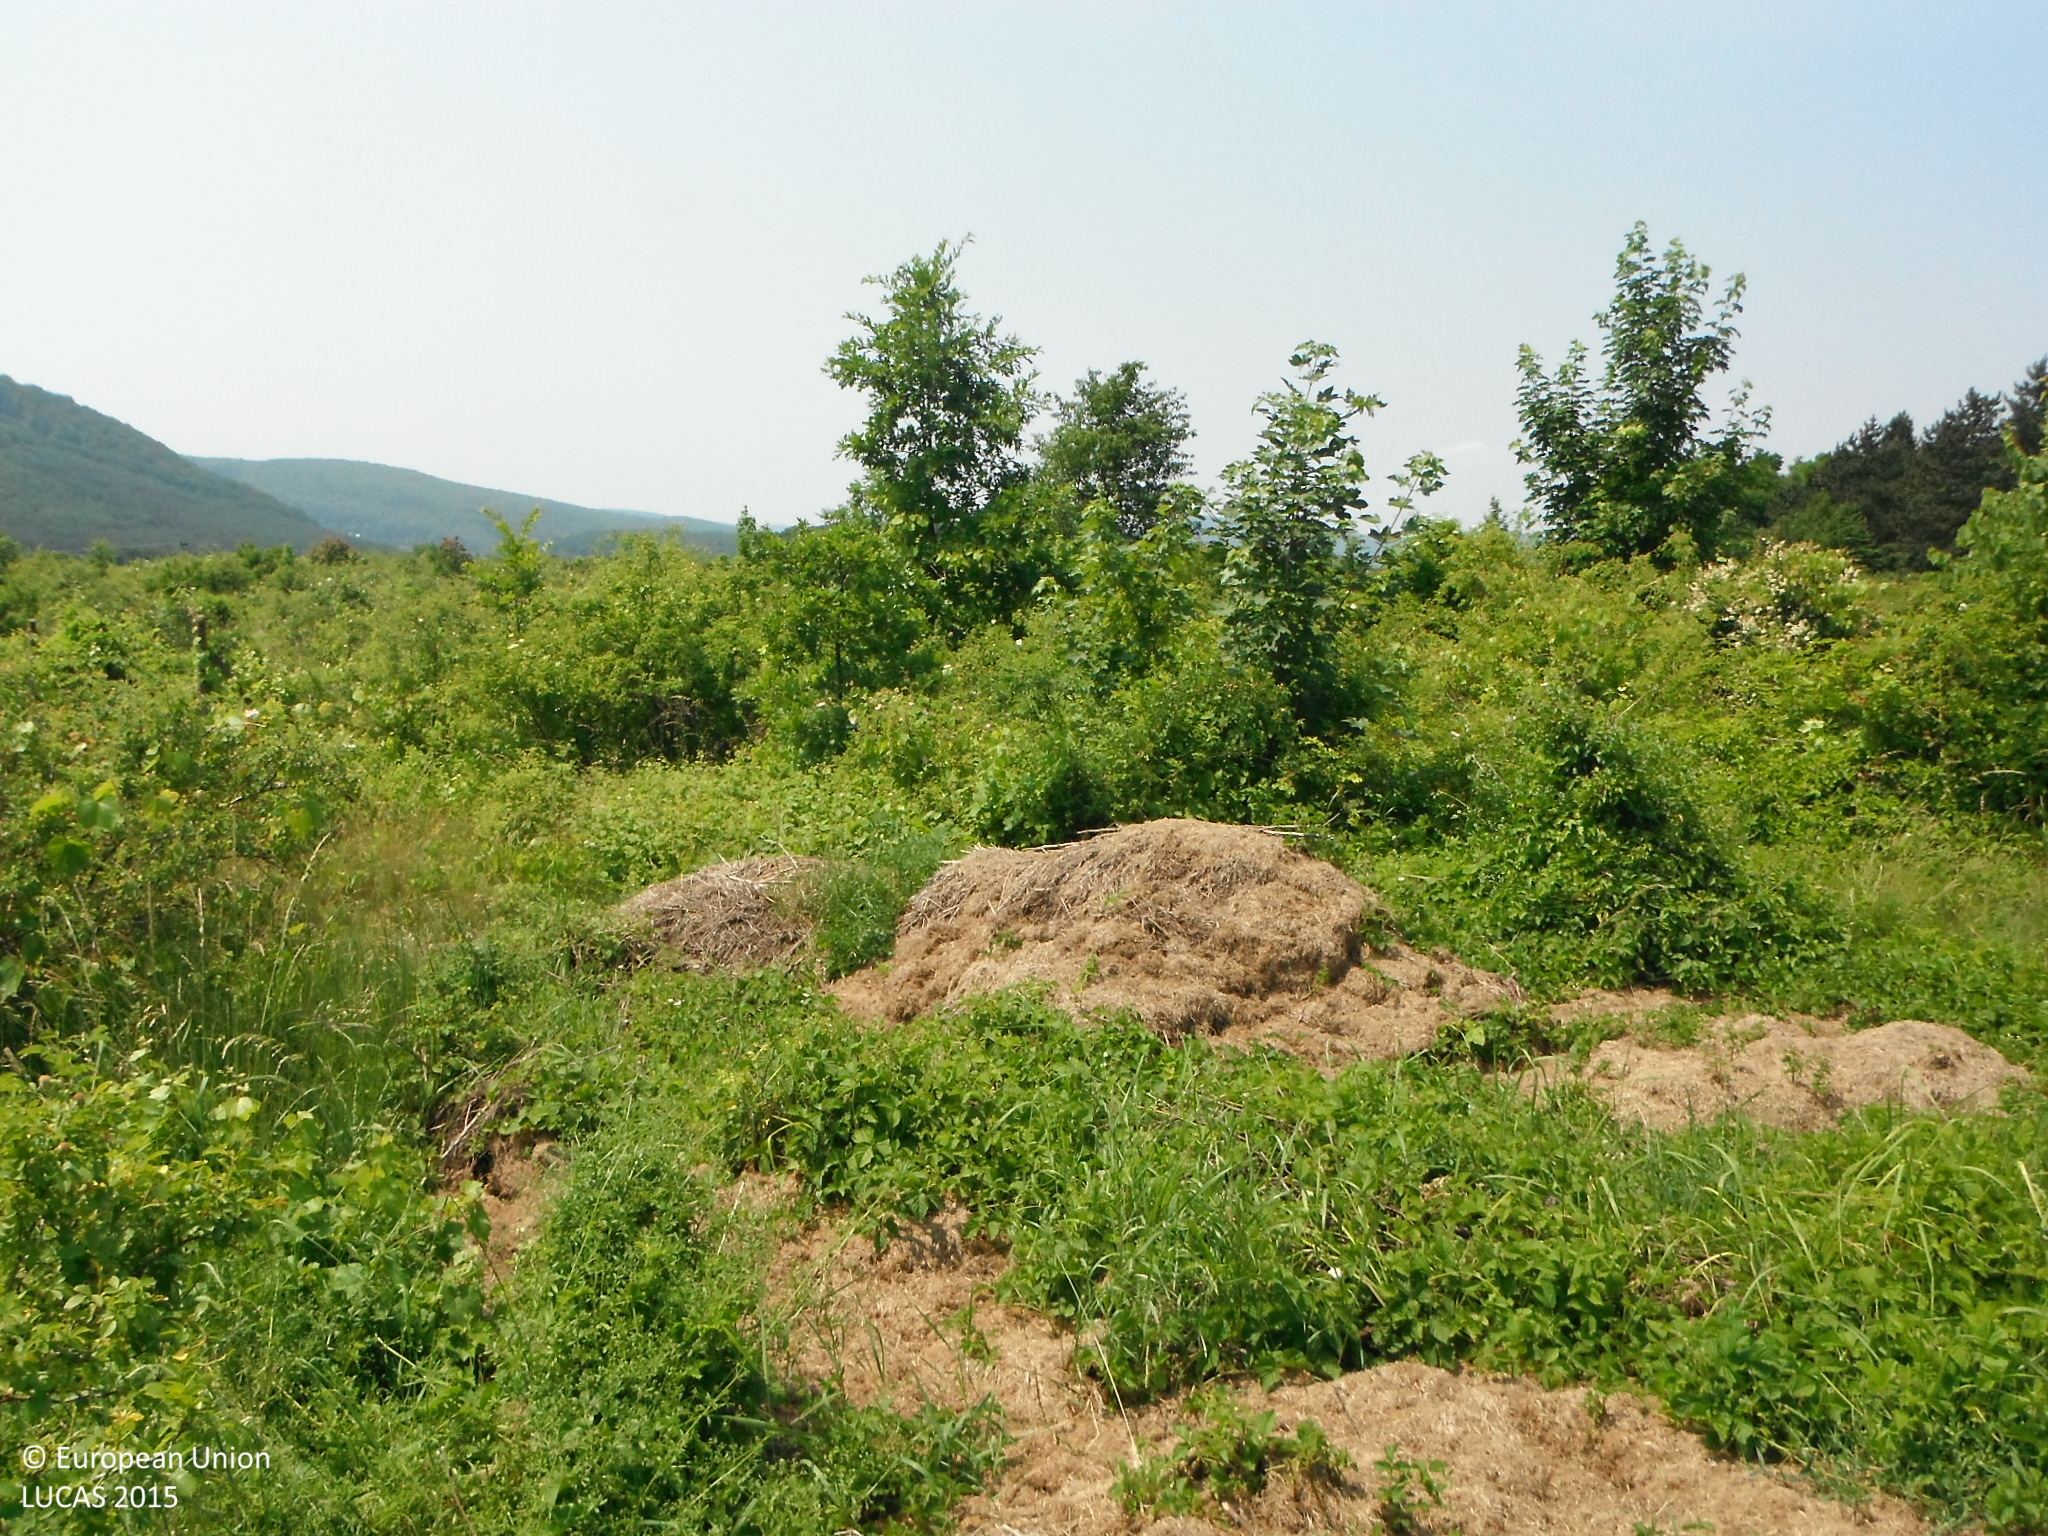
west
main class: Cropland
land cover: Vineyards
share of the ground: 50 - 75 %
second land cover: Shrubland without tree cover
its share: 50 - 75 %
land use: Abandoned areas
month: June
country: SK
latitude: 48.4781
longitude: 17.4371
